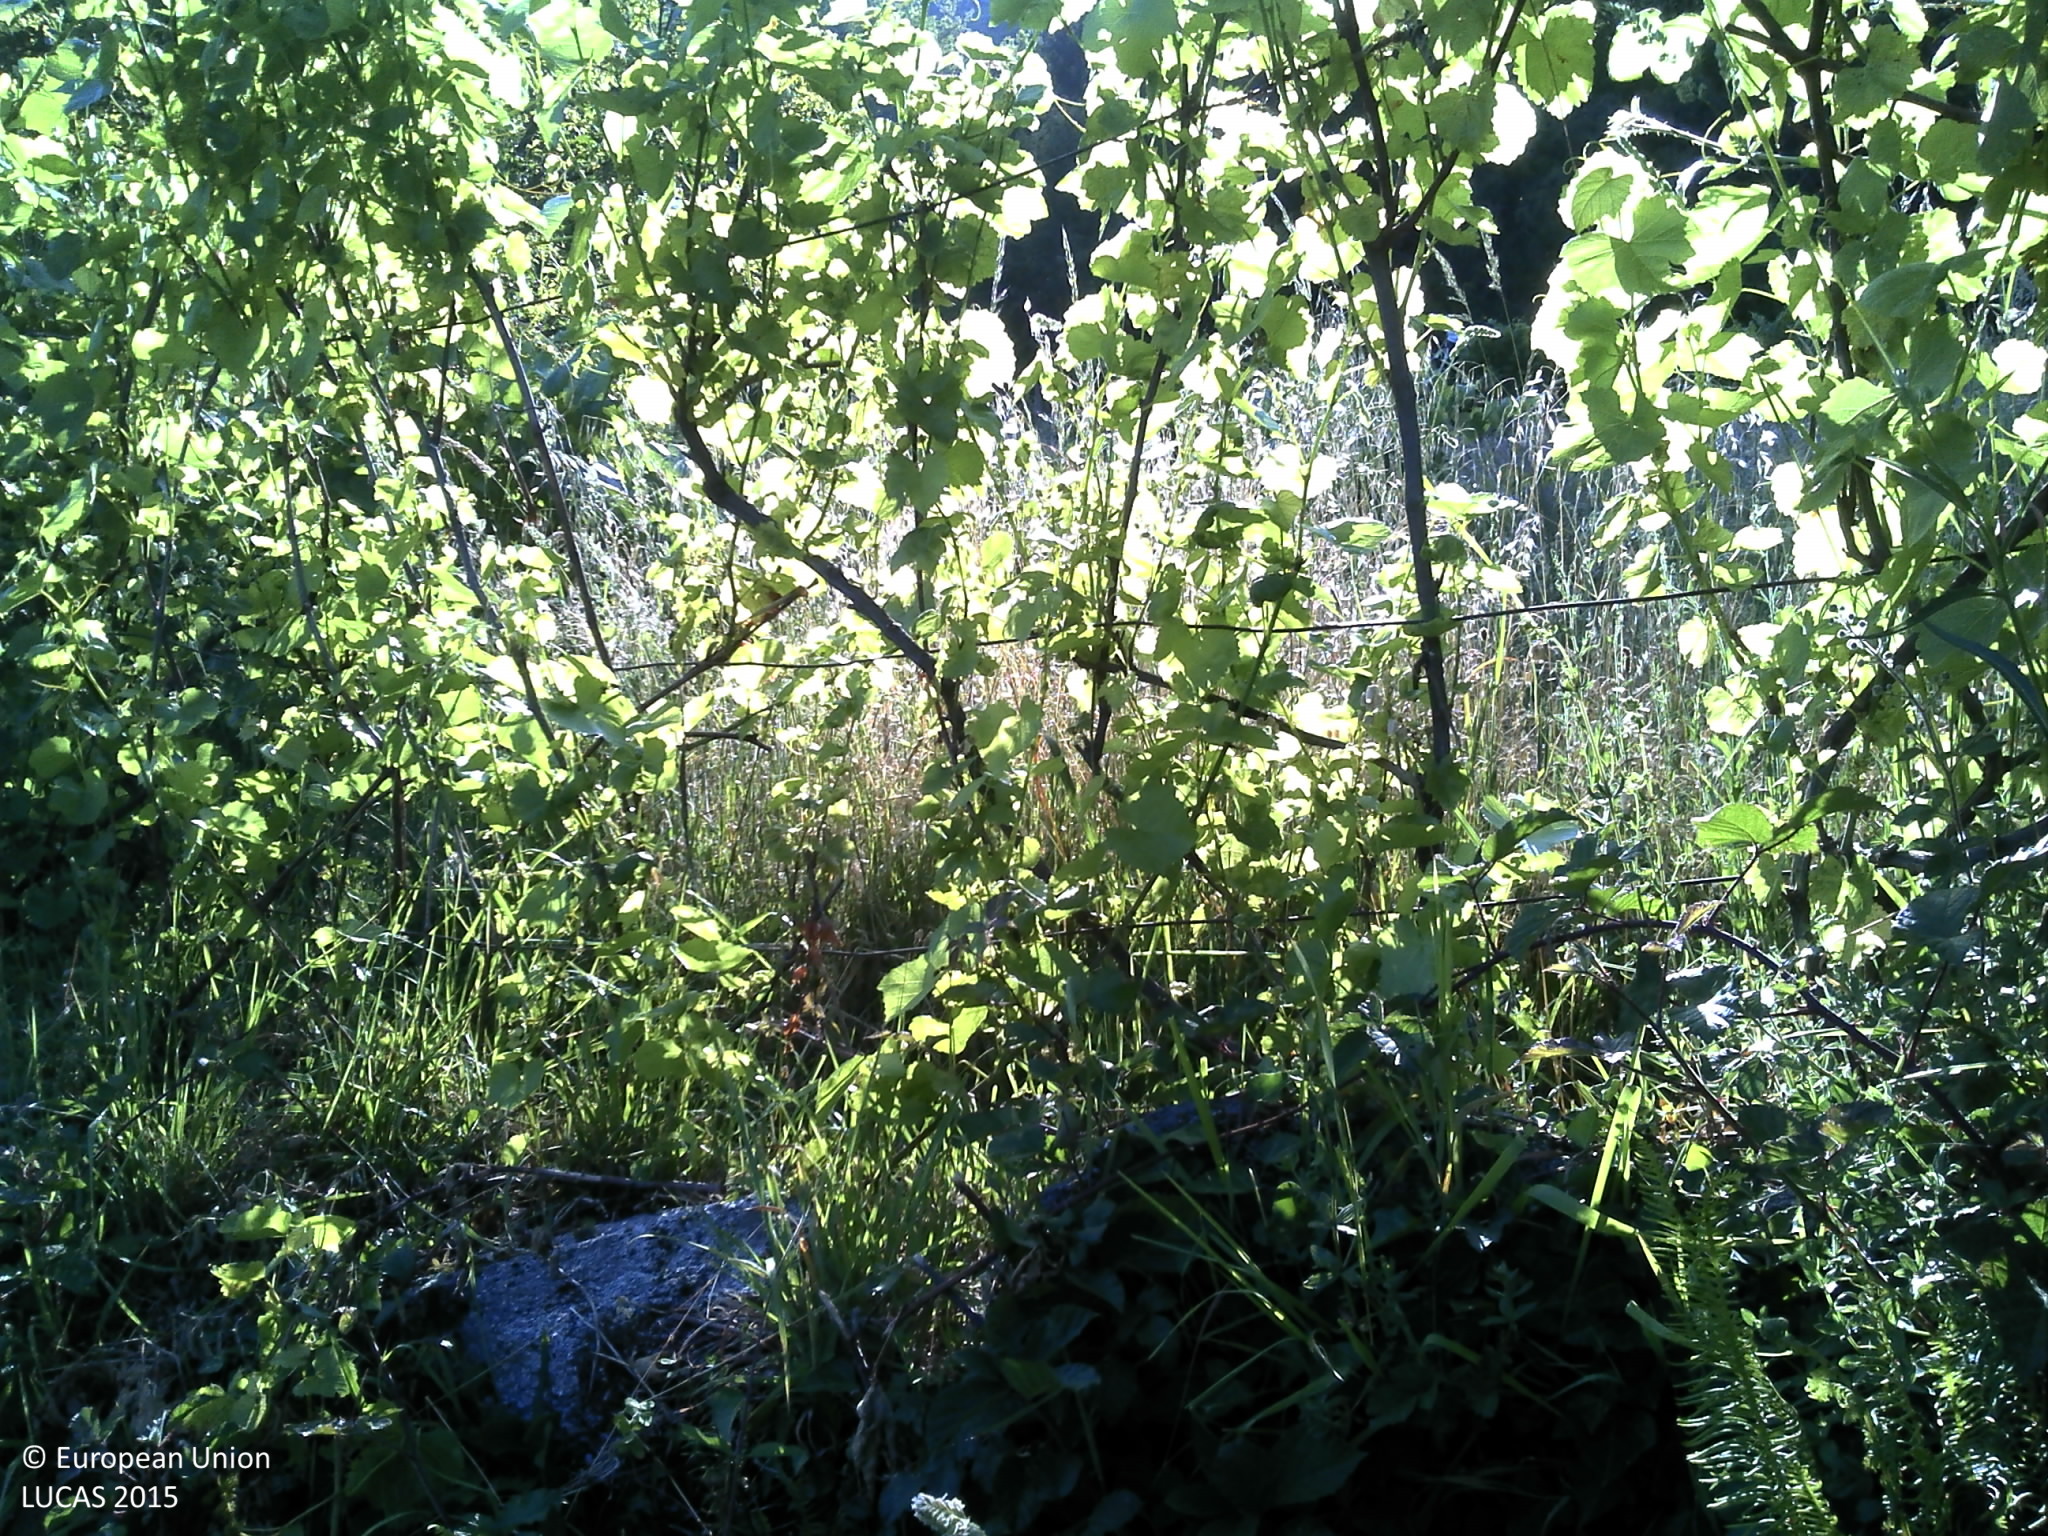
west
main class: Grassland
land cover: Grassland without tree/shrub cover
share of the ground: > 75 %
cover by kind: herbaceous plants 90 %, shrubs 5 %, unconsolidated bare surface 5 %
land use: Agriculture (excluding fallow land and kitchen gardens)
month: June
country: PT
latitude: 41.9510
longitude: -8.1883
